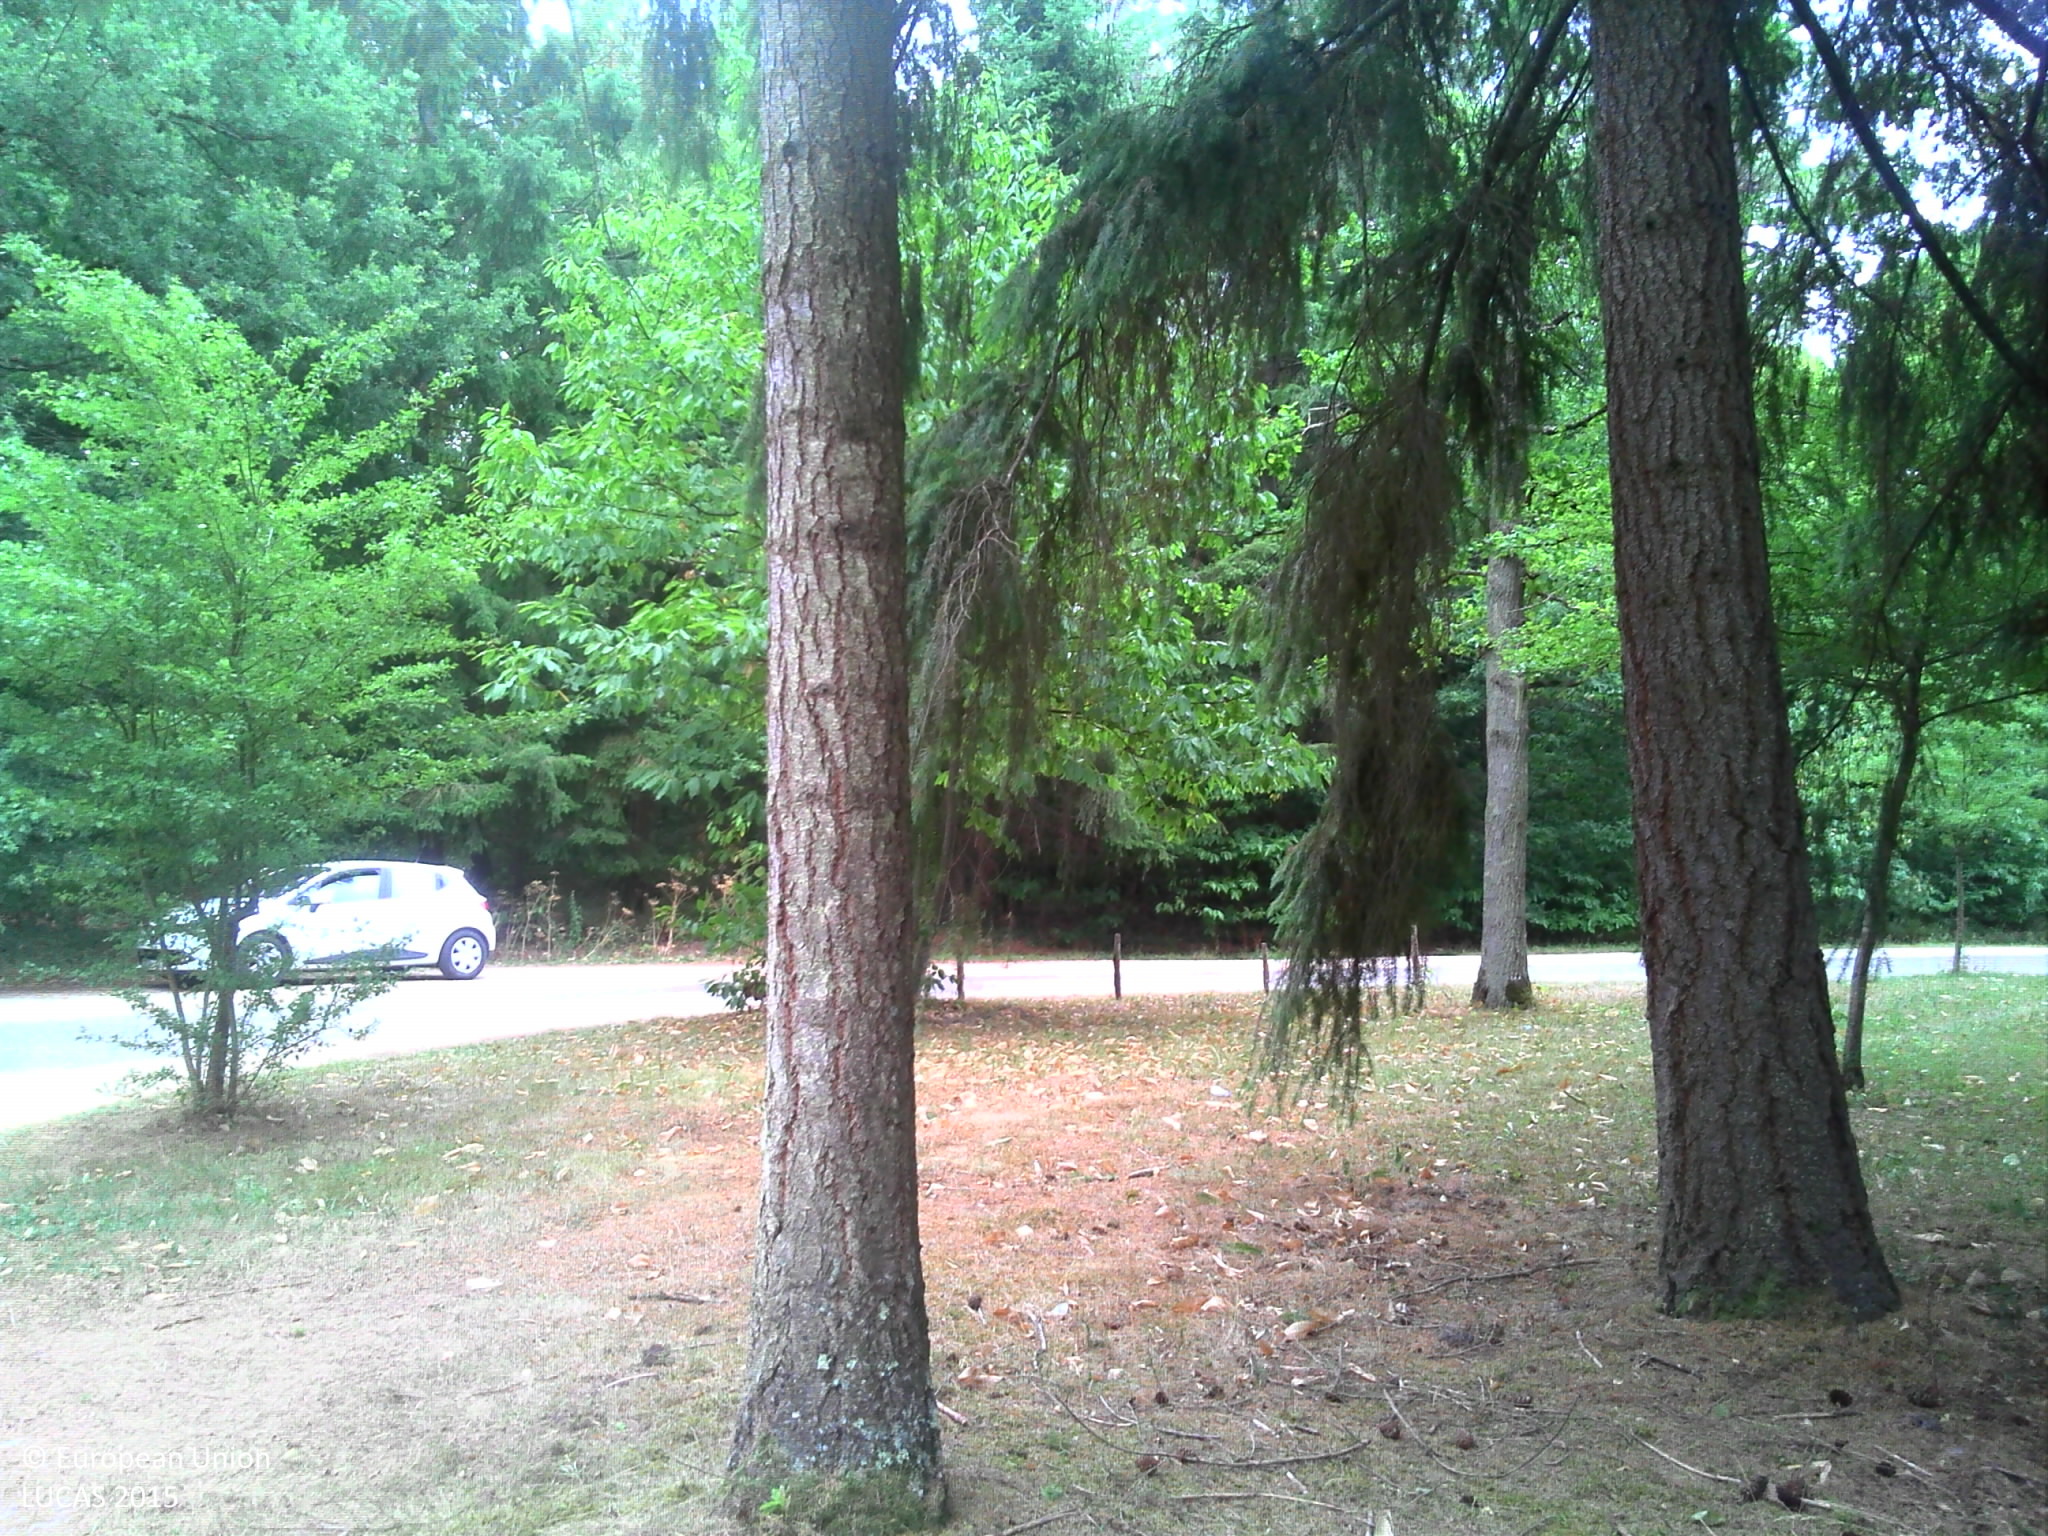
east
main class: Woodland
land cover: Spruce dominated coniferous woodland
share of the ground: > 75 %
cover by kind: coniferous forest trees 100 %
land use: Amenities, museums, leisure
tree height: > 5 m
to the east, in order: Spruce dominated coniferous woodland; Paved roads, cycling and walking lanes; Grass margins; Ditches and canals; Spruce dominated mixed woodland; Tracks; Spruce dominated mixed woodland; Ditches and canals; Tracks; Broadleaved woodland
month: July
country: FR
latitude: 47.9323
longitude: 1.9970
